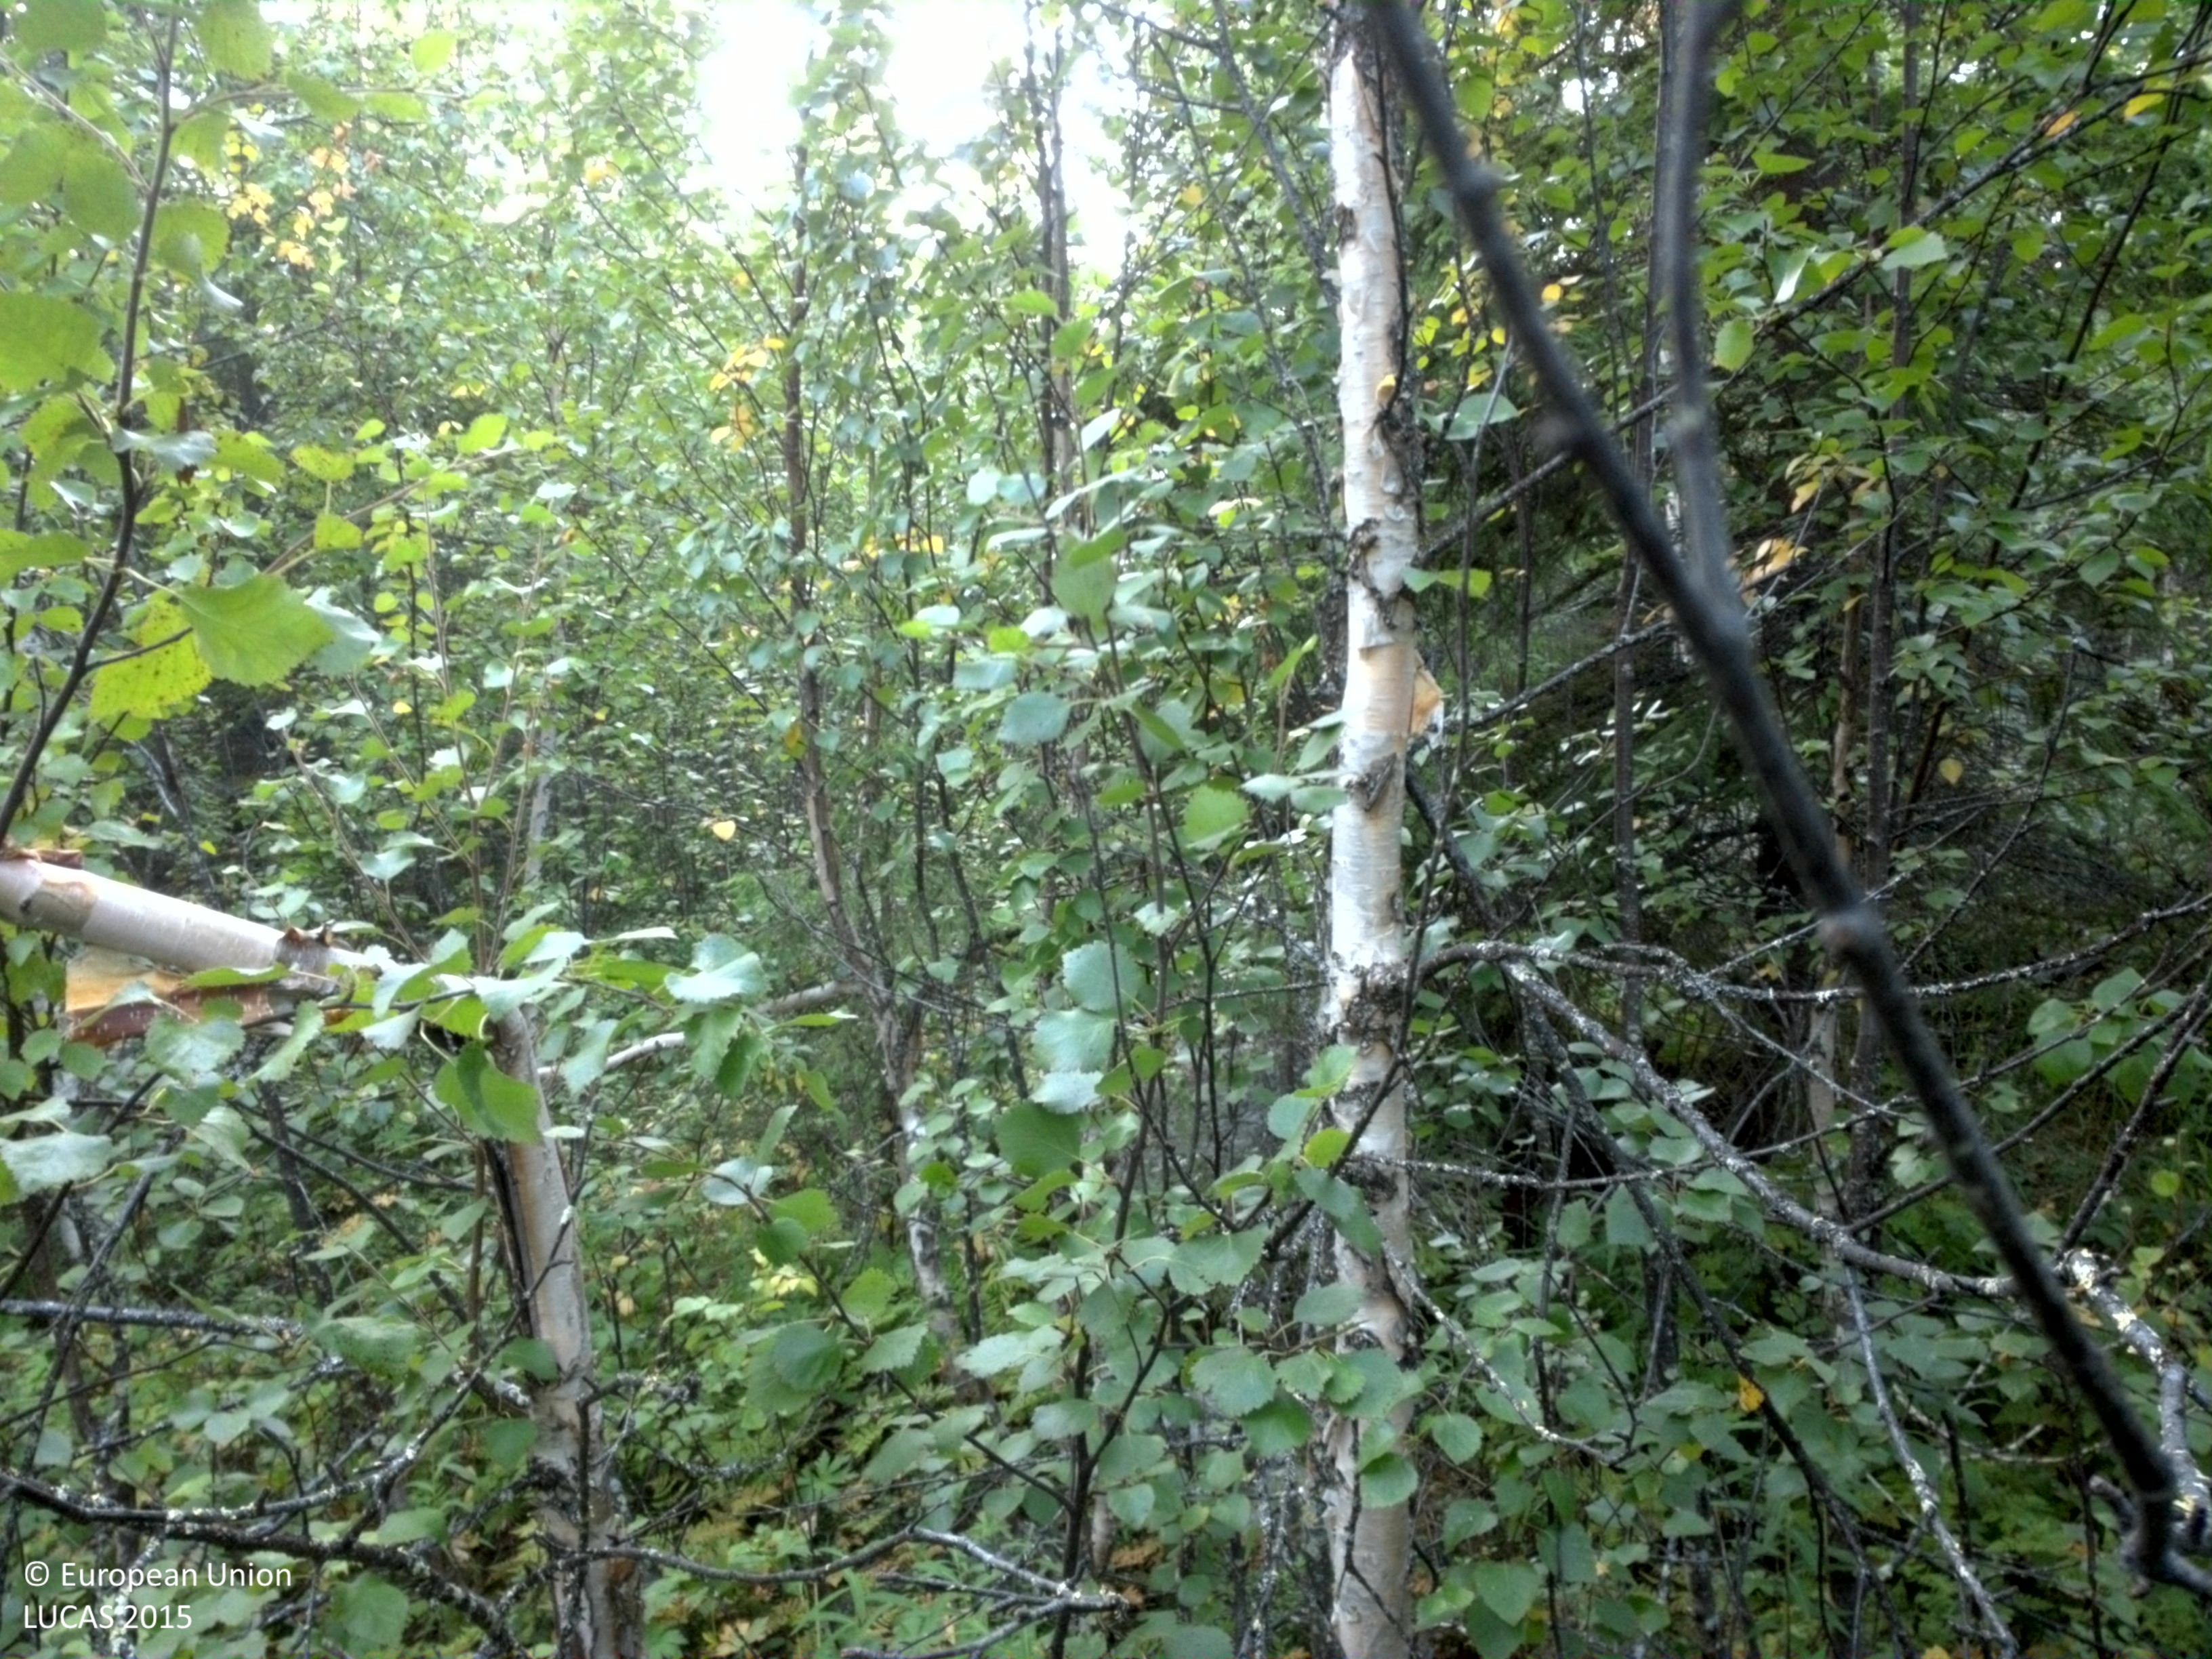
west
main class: Woodland
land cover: Spruce dominated mixed woodland
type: boreal forest
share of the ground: 50 - 75 %
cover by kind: broadleaved forest trees 40 %, coniferous forest trees 30 %, shrubs 15 %, herbaceous plants 15 %
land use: Forestry
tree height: > 5 m
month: September
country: SE
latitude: 65.1825
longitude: 16.2204
